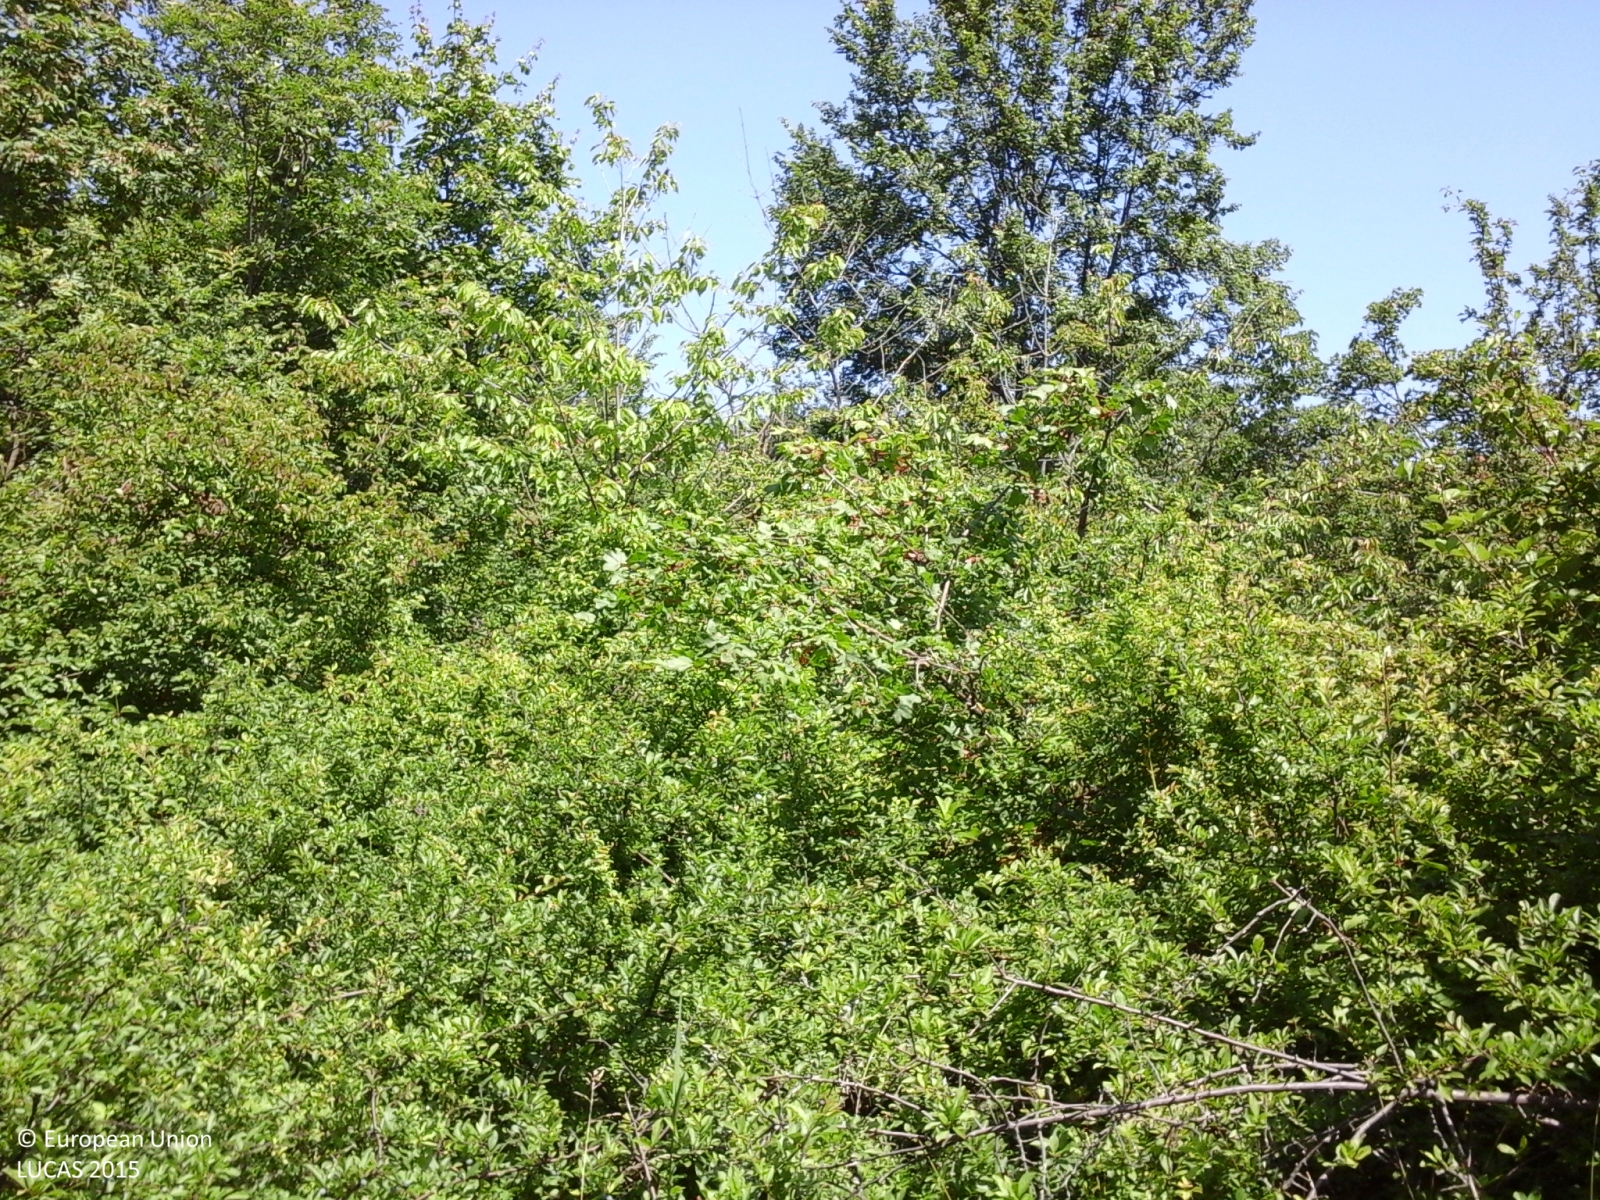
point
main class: Woodland
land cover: Broadleaved woodland
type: thermophilous deciduous forest
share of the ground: > 75 %
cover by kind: broadleaved forest trees 75 %, shrubs 25 %
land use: Forestry
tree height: > 5 m
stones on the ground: < 10 %
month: May
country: IT
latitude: 44.7653
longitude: 10.0630
